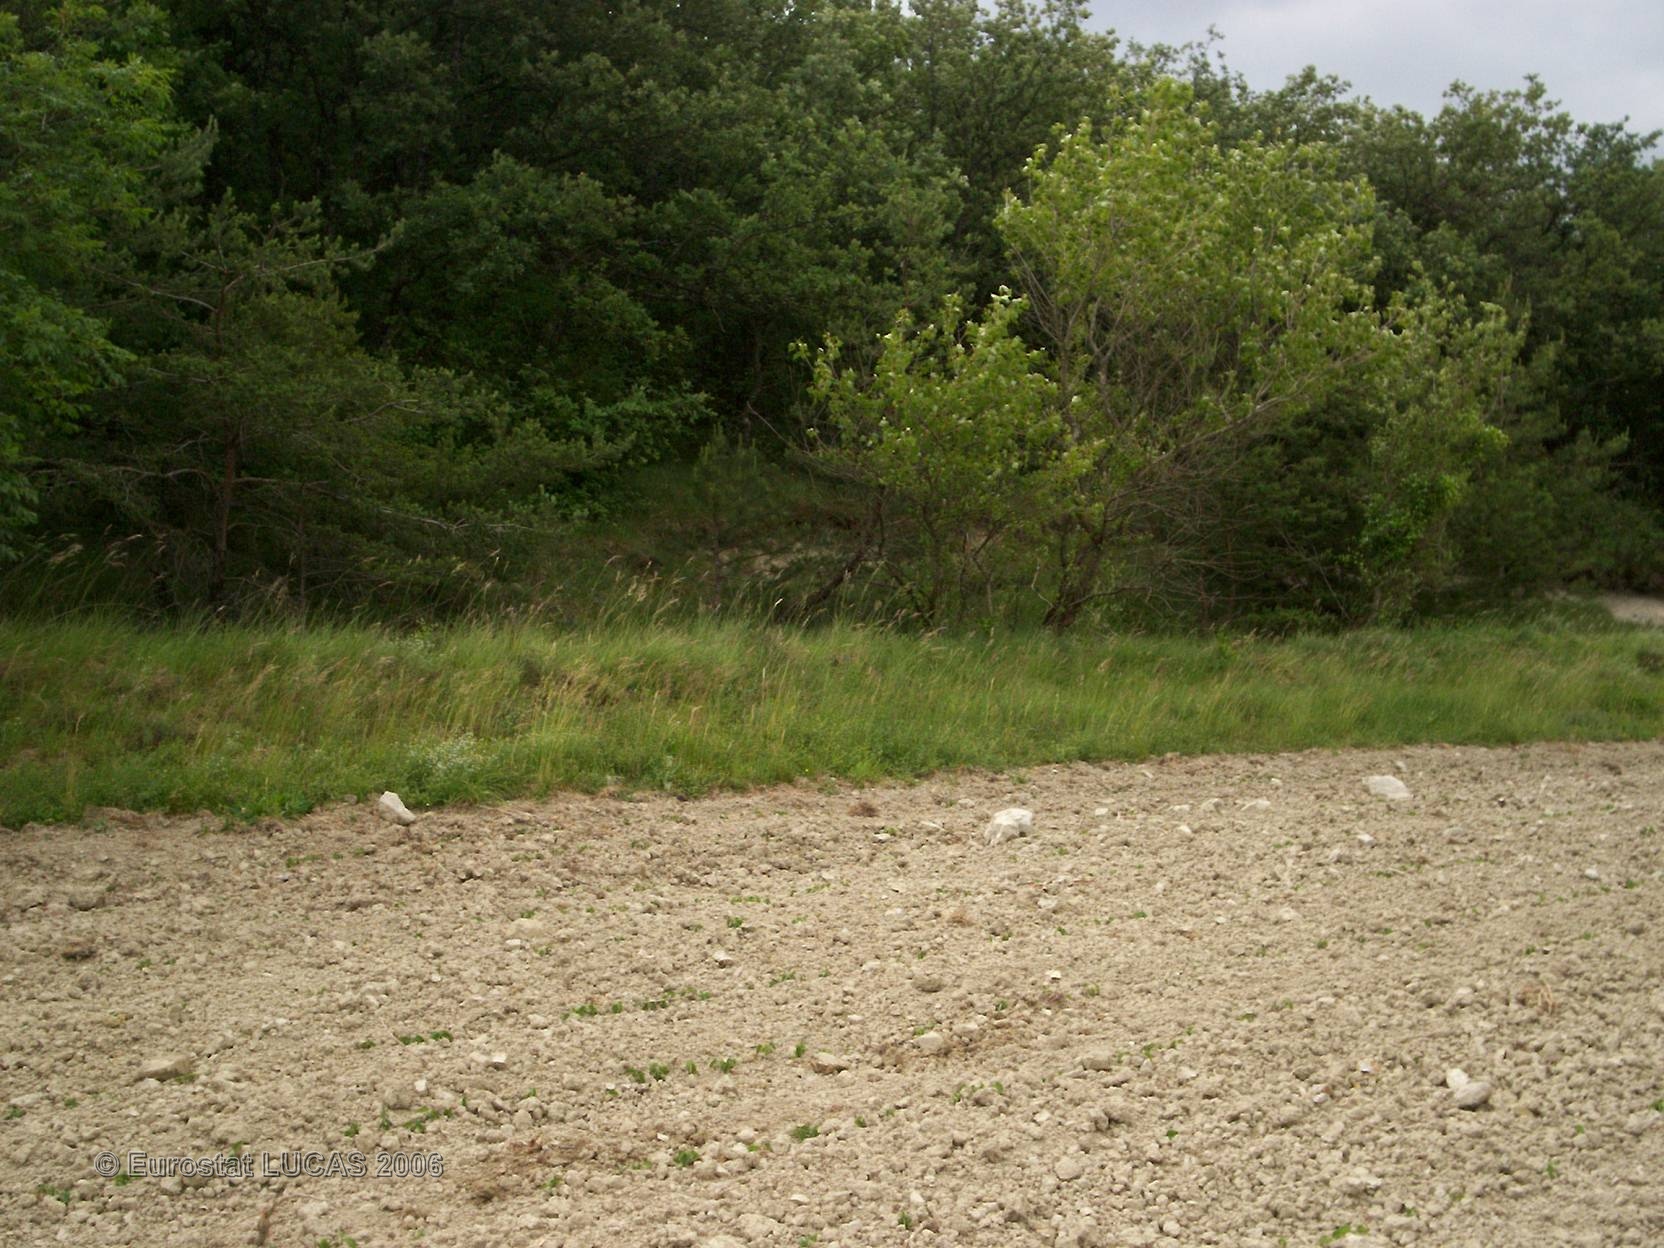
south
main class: Cropland
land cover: Soya
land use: Agriculture (excluding fallow land and kitchen gardens)
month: June
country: FR
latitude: 44.5341
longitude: 4.9354
